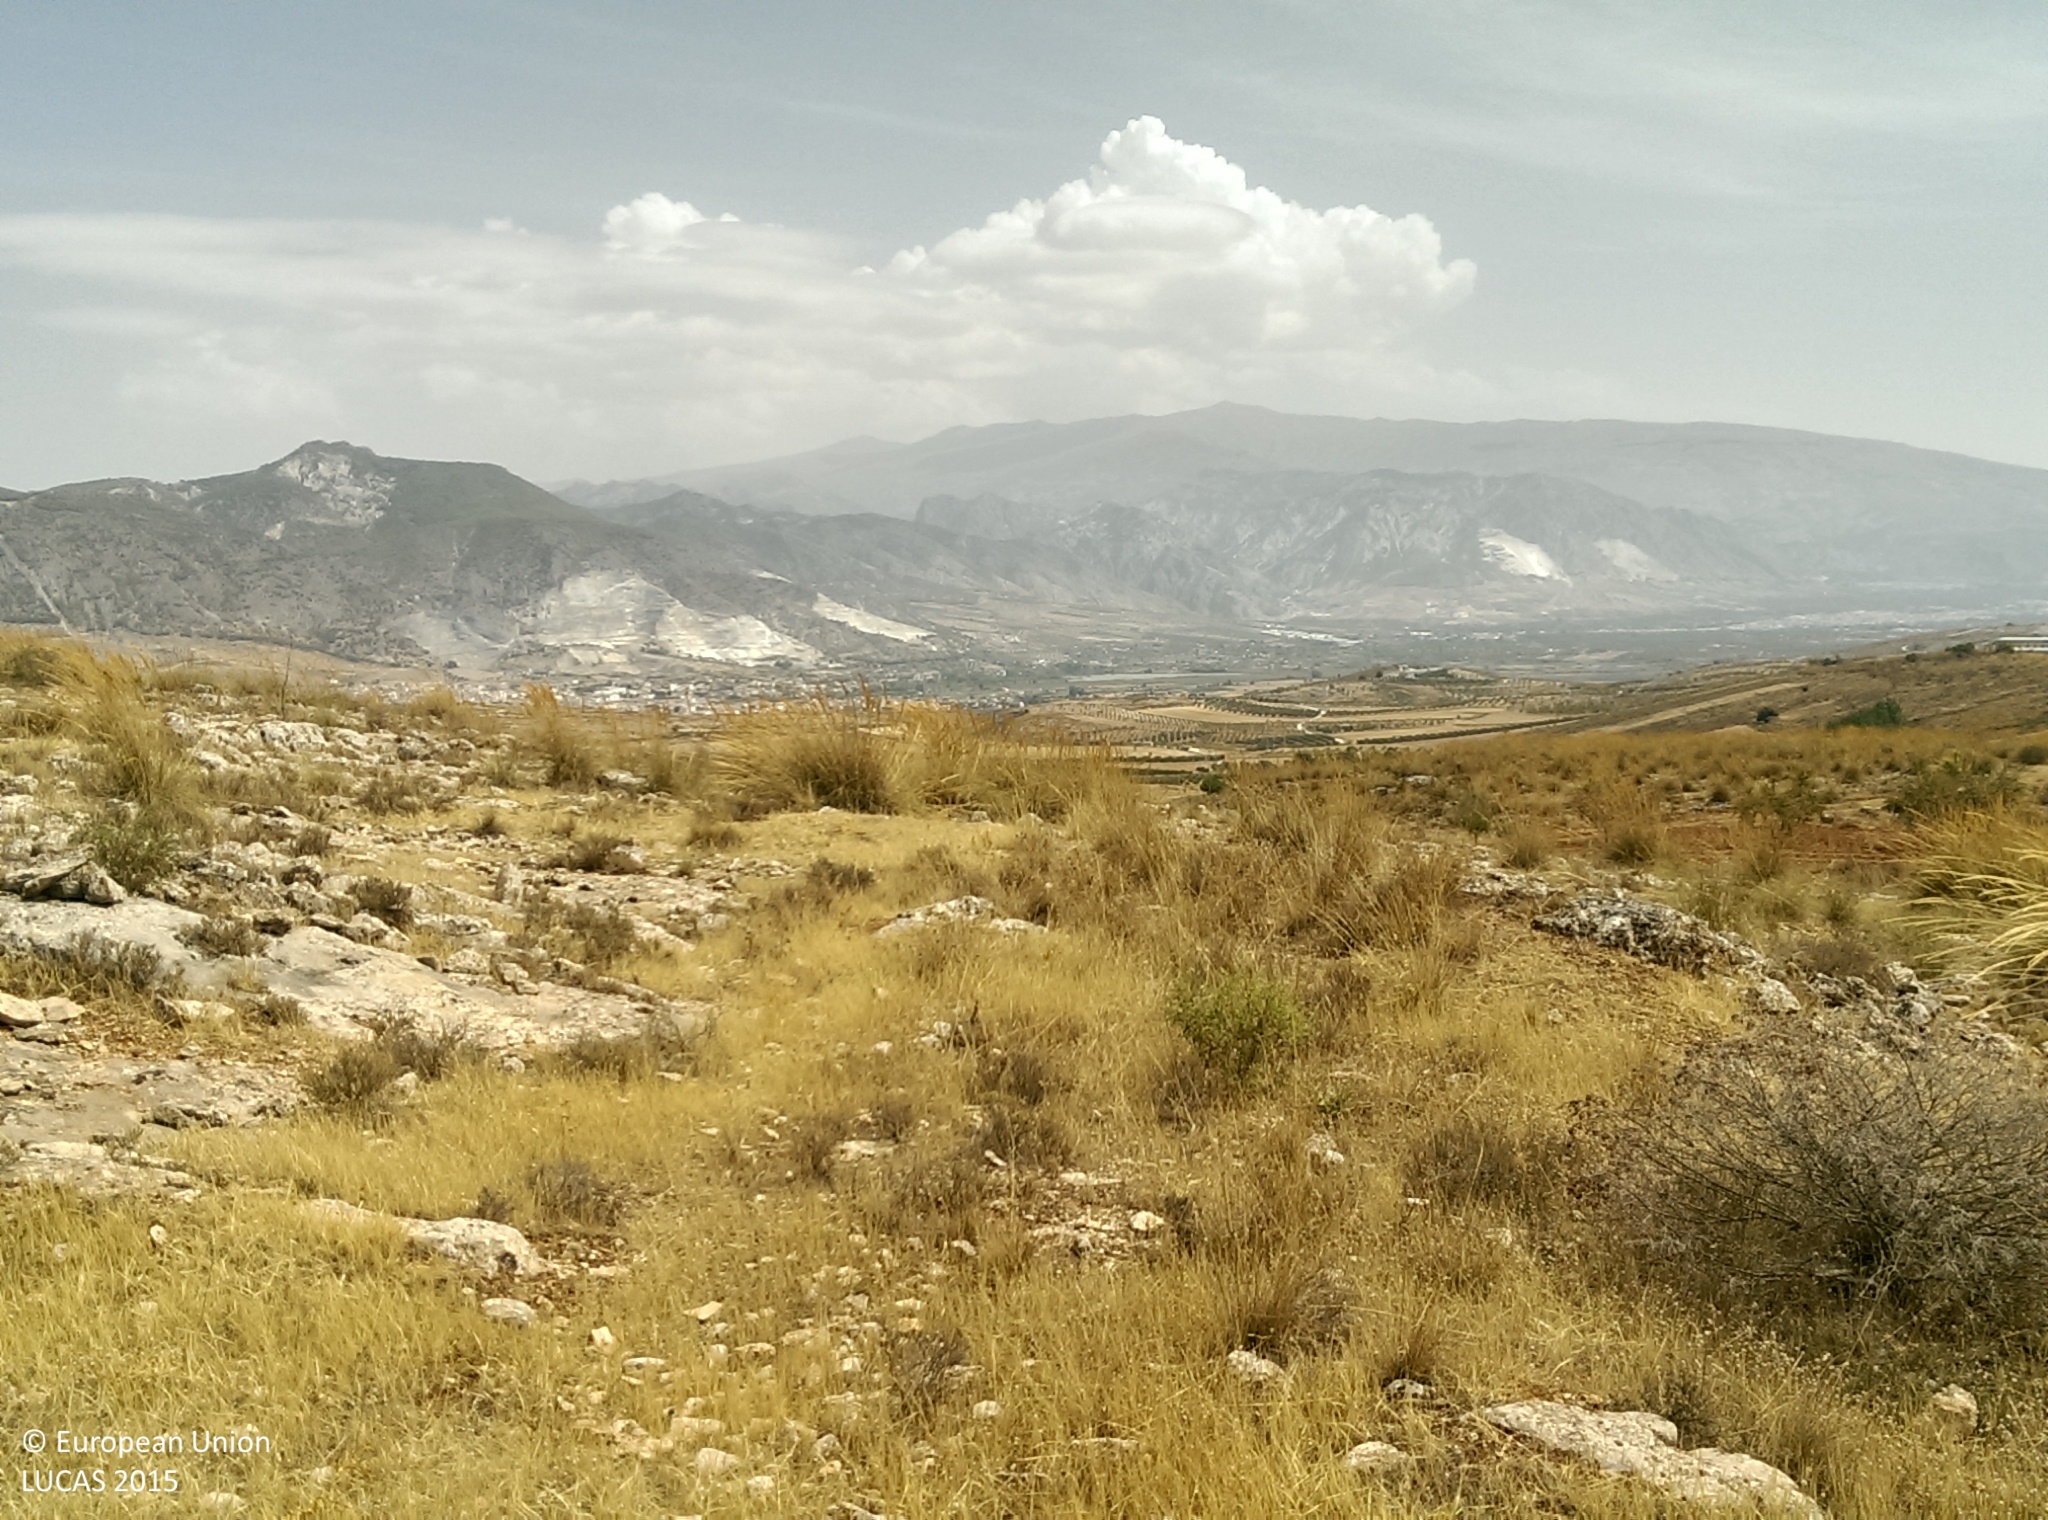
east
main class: Grassland
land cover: Grassland without tree/shrub cover
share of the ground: 50 - 75 %
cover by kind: herbaceous plants 75 %, consolidated bare surface 15 %, unconsolidated bare surface 10 %
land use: Abandoned areas
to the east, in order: Grassland without tree/shrub cover; Tracks; Grassland without tree/shrub cover; Shrubland without tree cover; Nuts trees
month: August
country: ES
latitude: 37.0132
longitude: -3.6650
